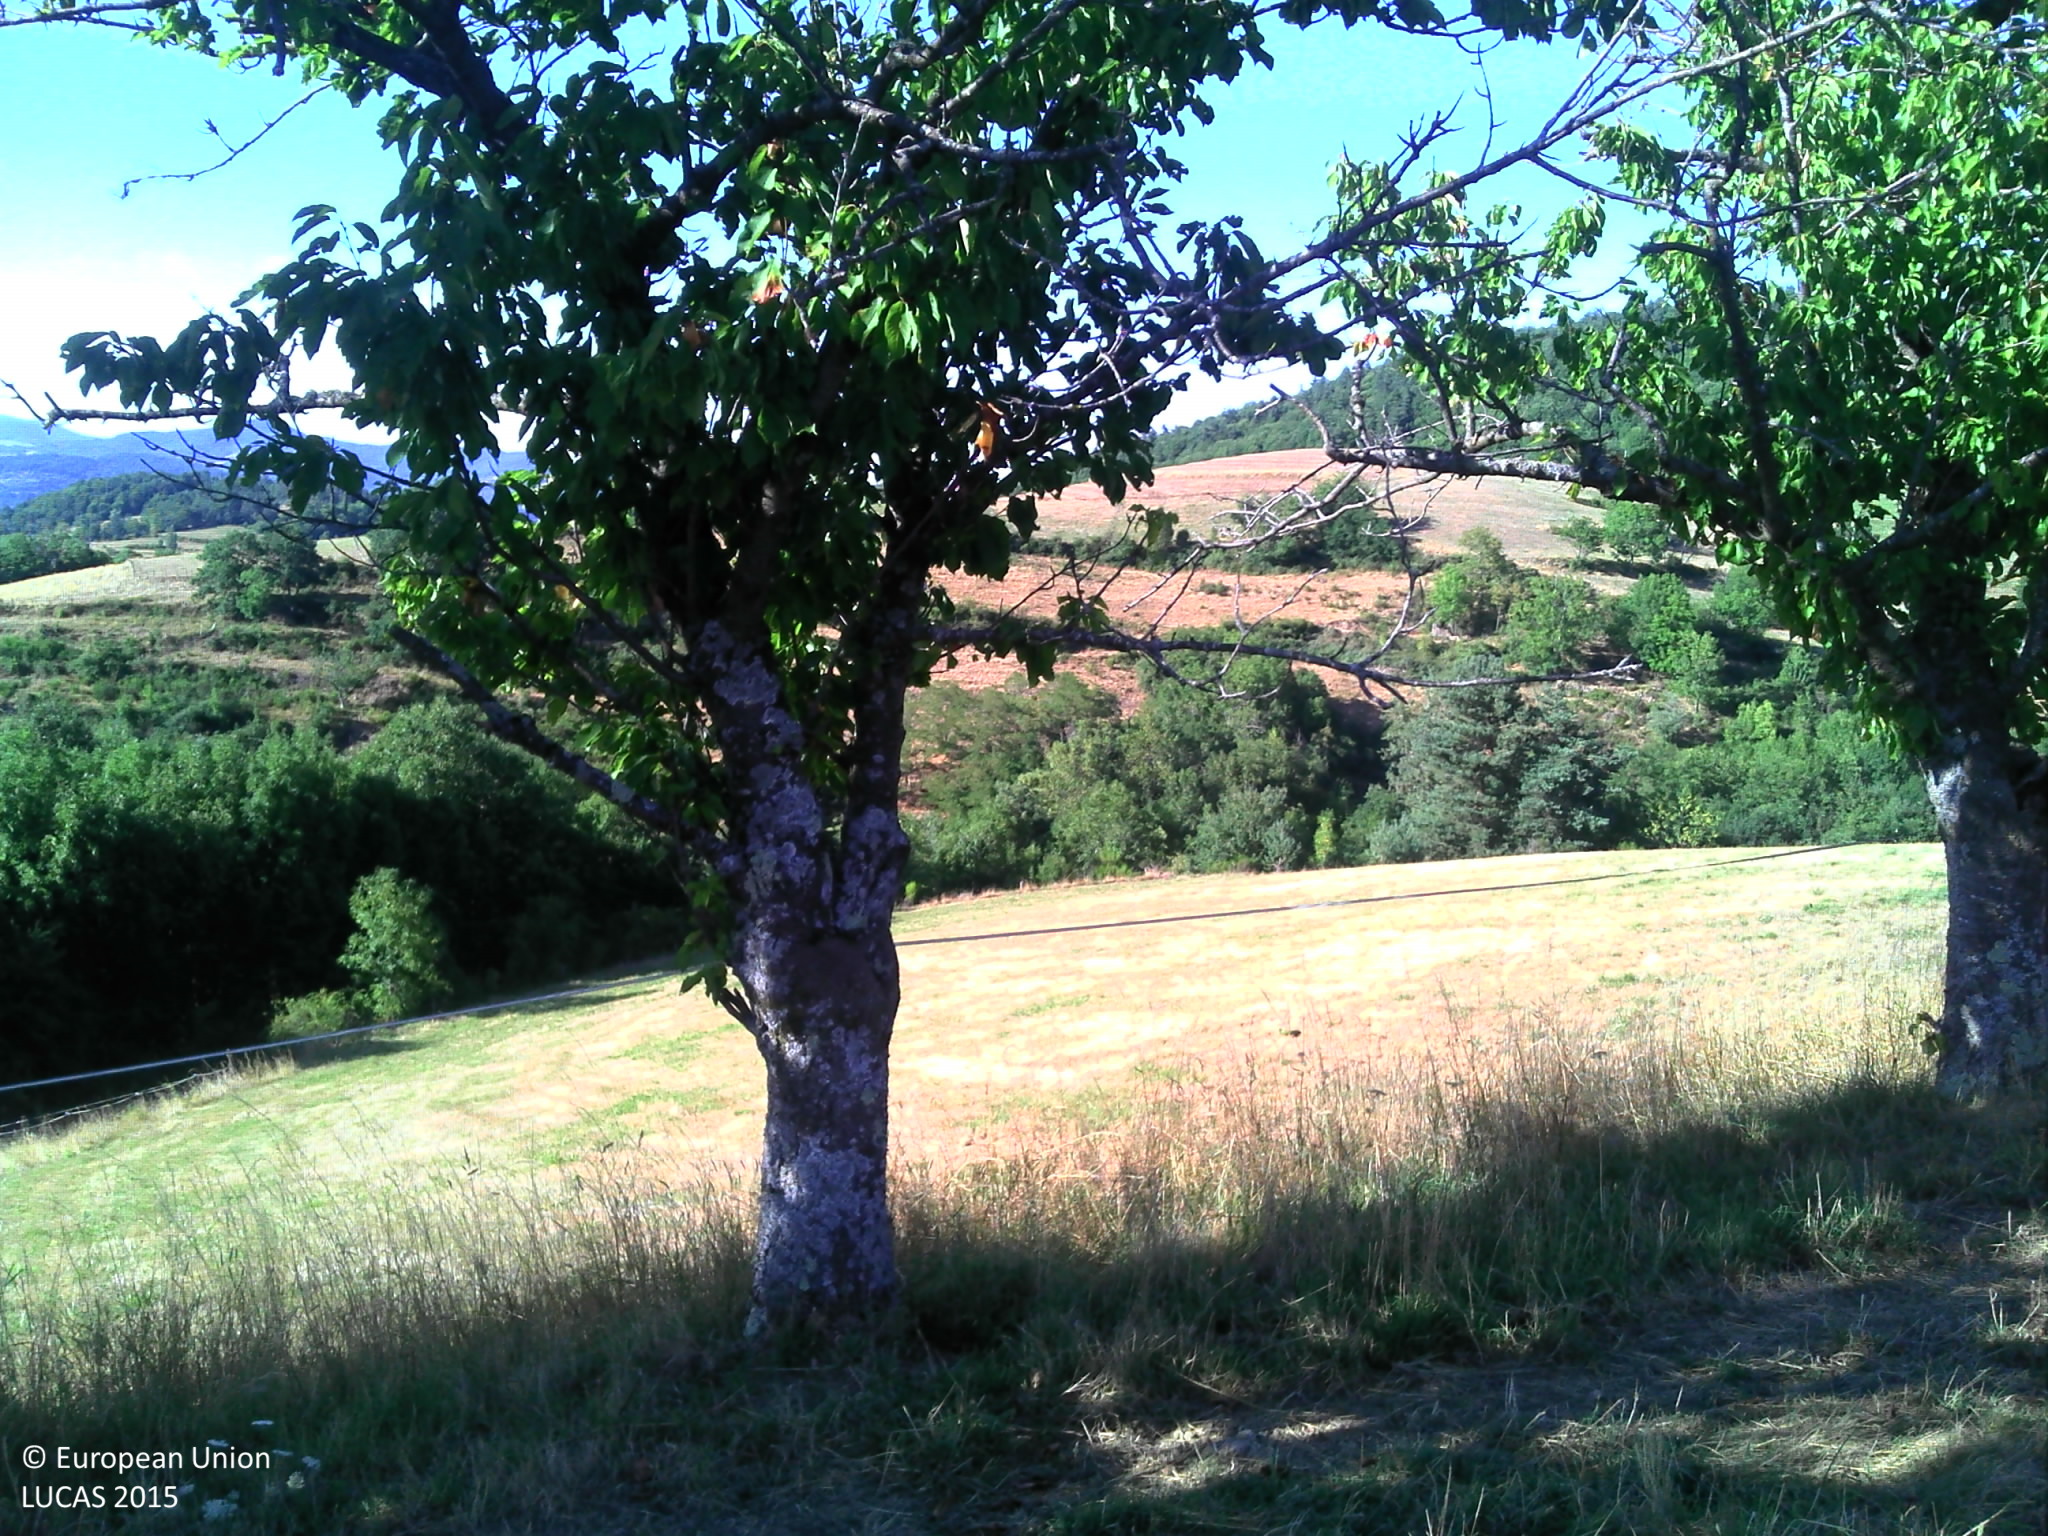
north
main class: Grassland
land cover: Grassland without tree/shrub cover
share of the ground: > 75 %
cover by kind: herbaceous plants 100 %
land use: Agriculture (excluding fallow land and kitchen gardens)
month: July
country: FR
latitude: 44.9504
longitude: 4.5932
